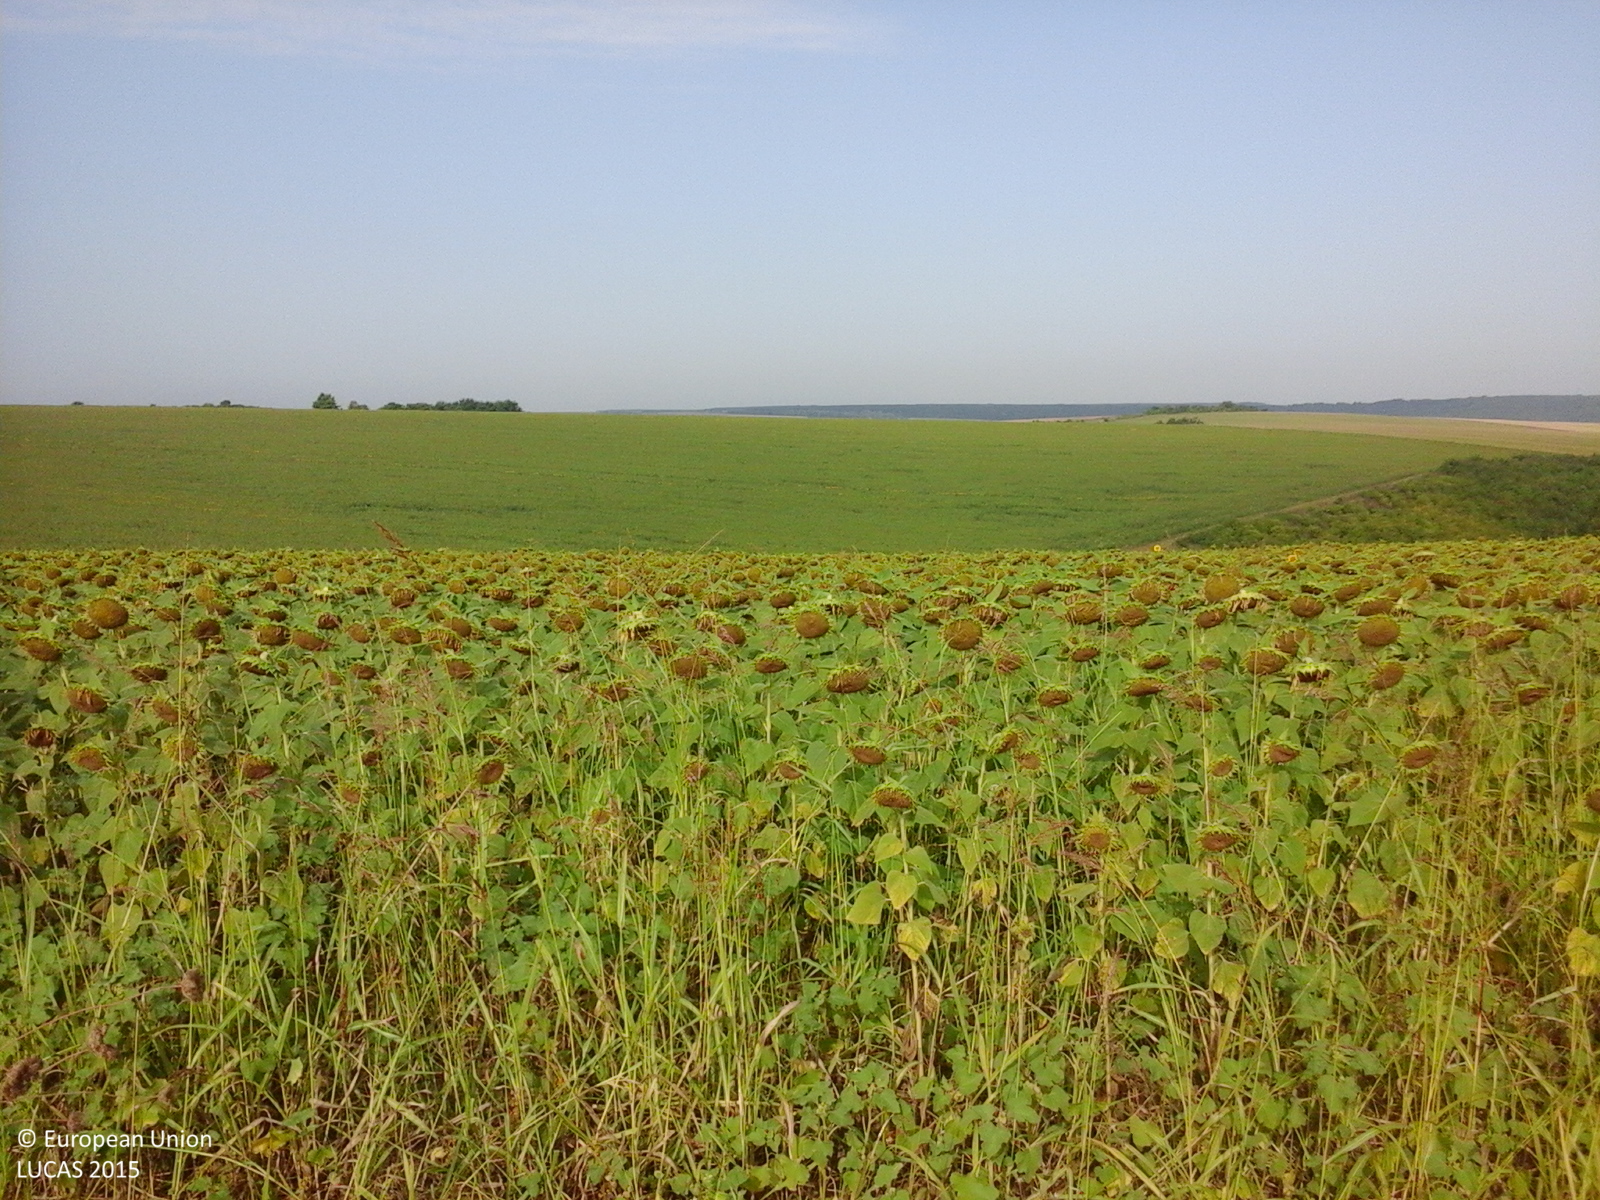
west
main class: Cropland
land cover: Sunflower
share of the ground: > 75 %
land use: Agriculture (excluding fallow land and kitchen gardens)
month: August
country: RO
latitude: 44.0350
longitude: 27.6745
